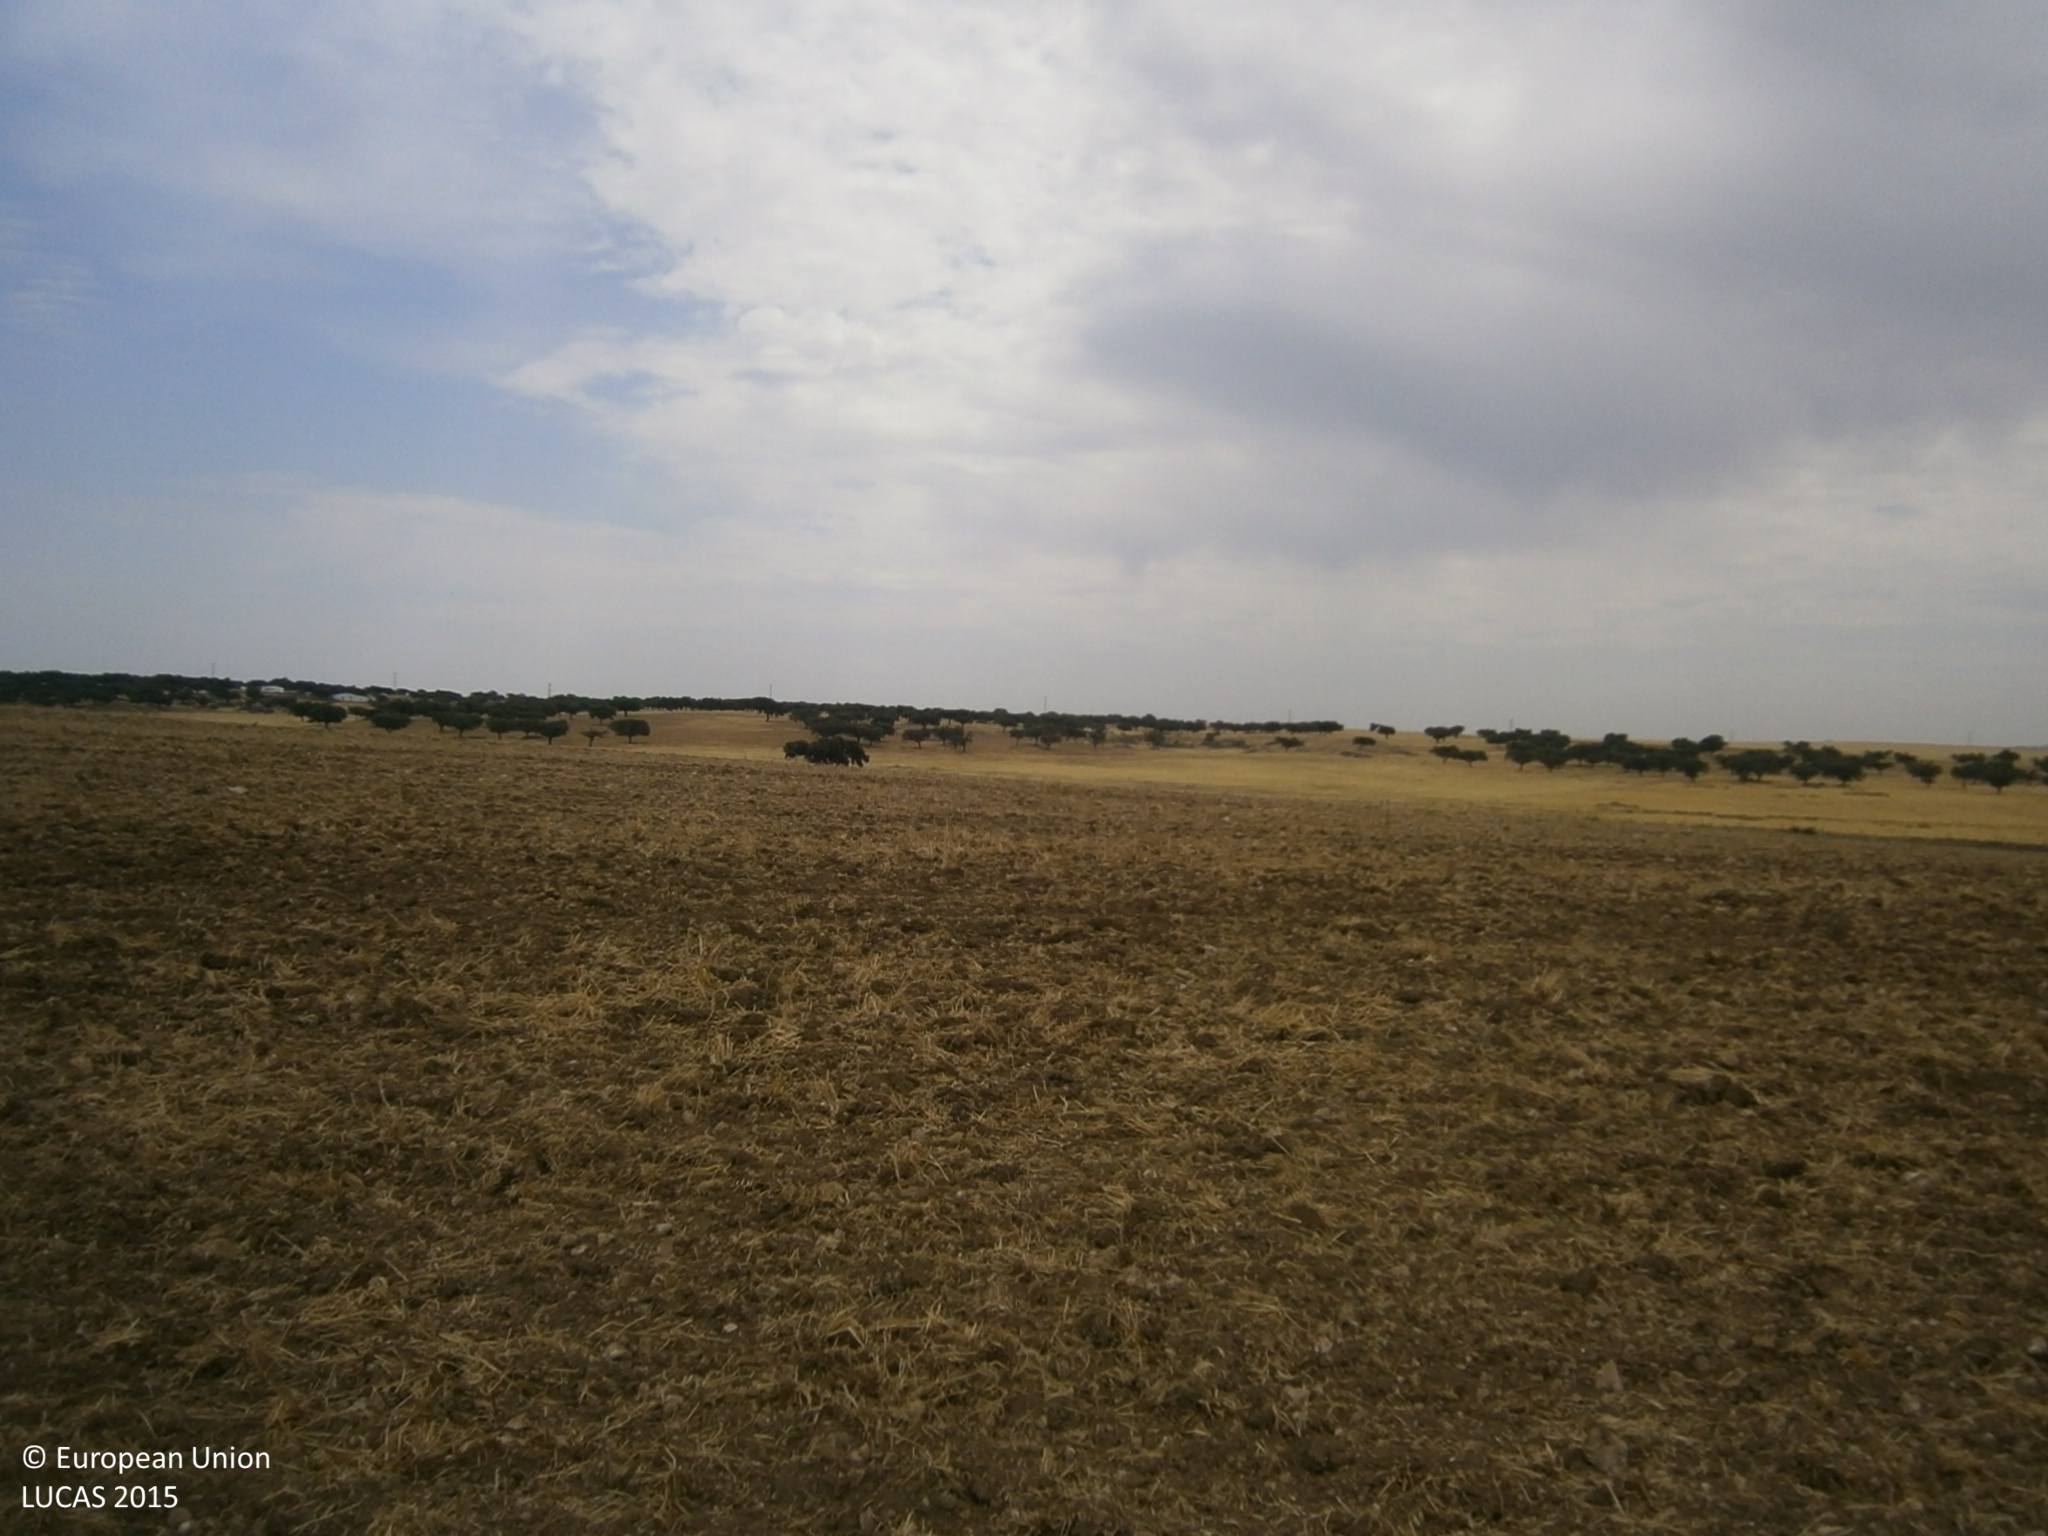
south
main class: Cropland
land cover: Durum wheat
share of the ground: > 75 %
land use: Agriculture (excluding fallow land and kitchen gardens)
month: June
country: ES
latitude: 38.9939
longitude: -6.4679
